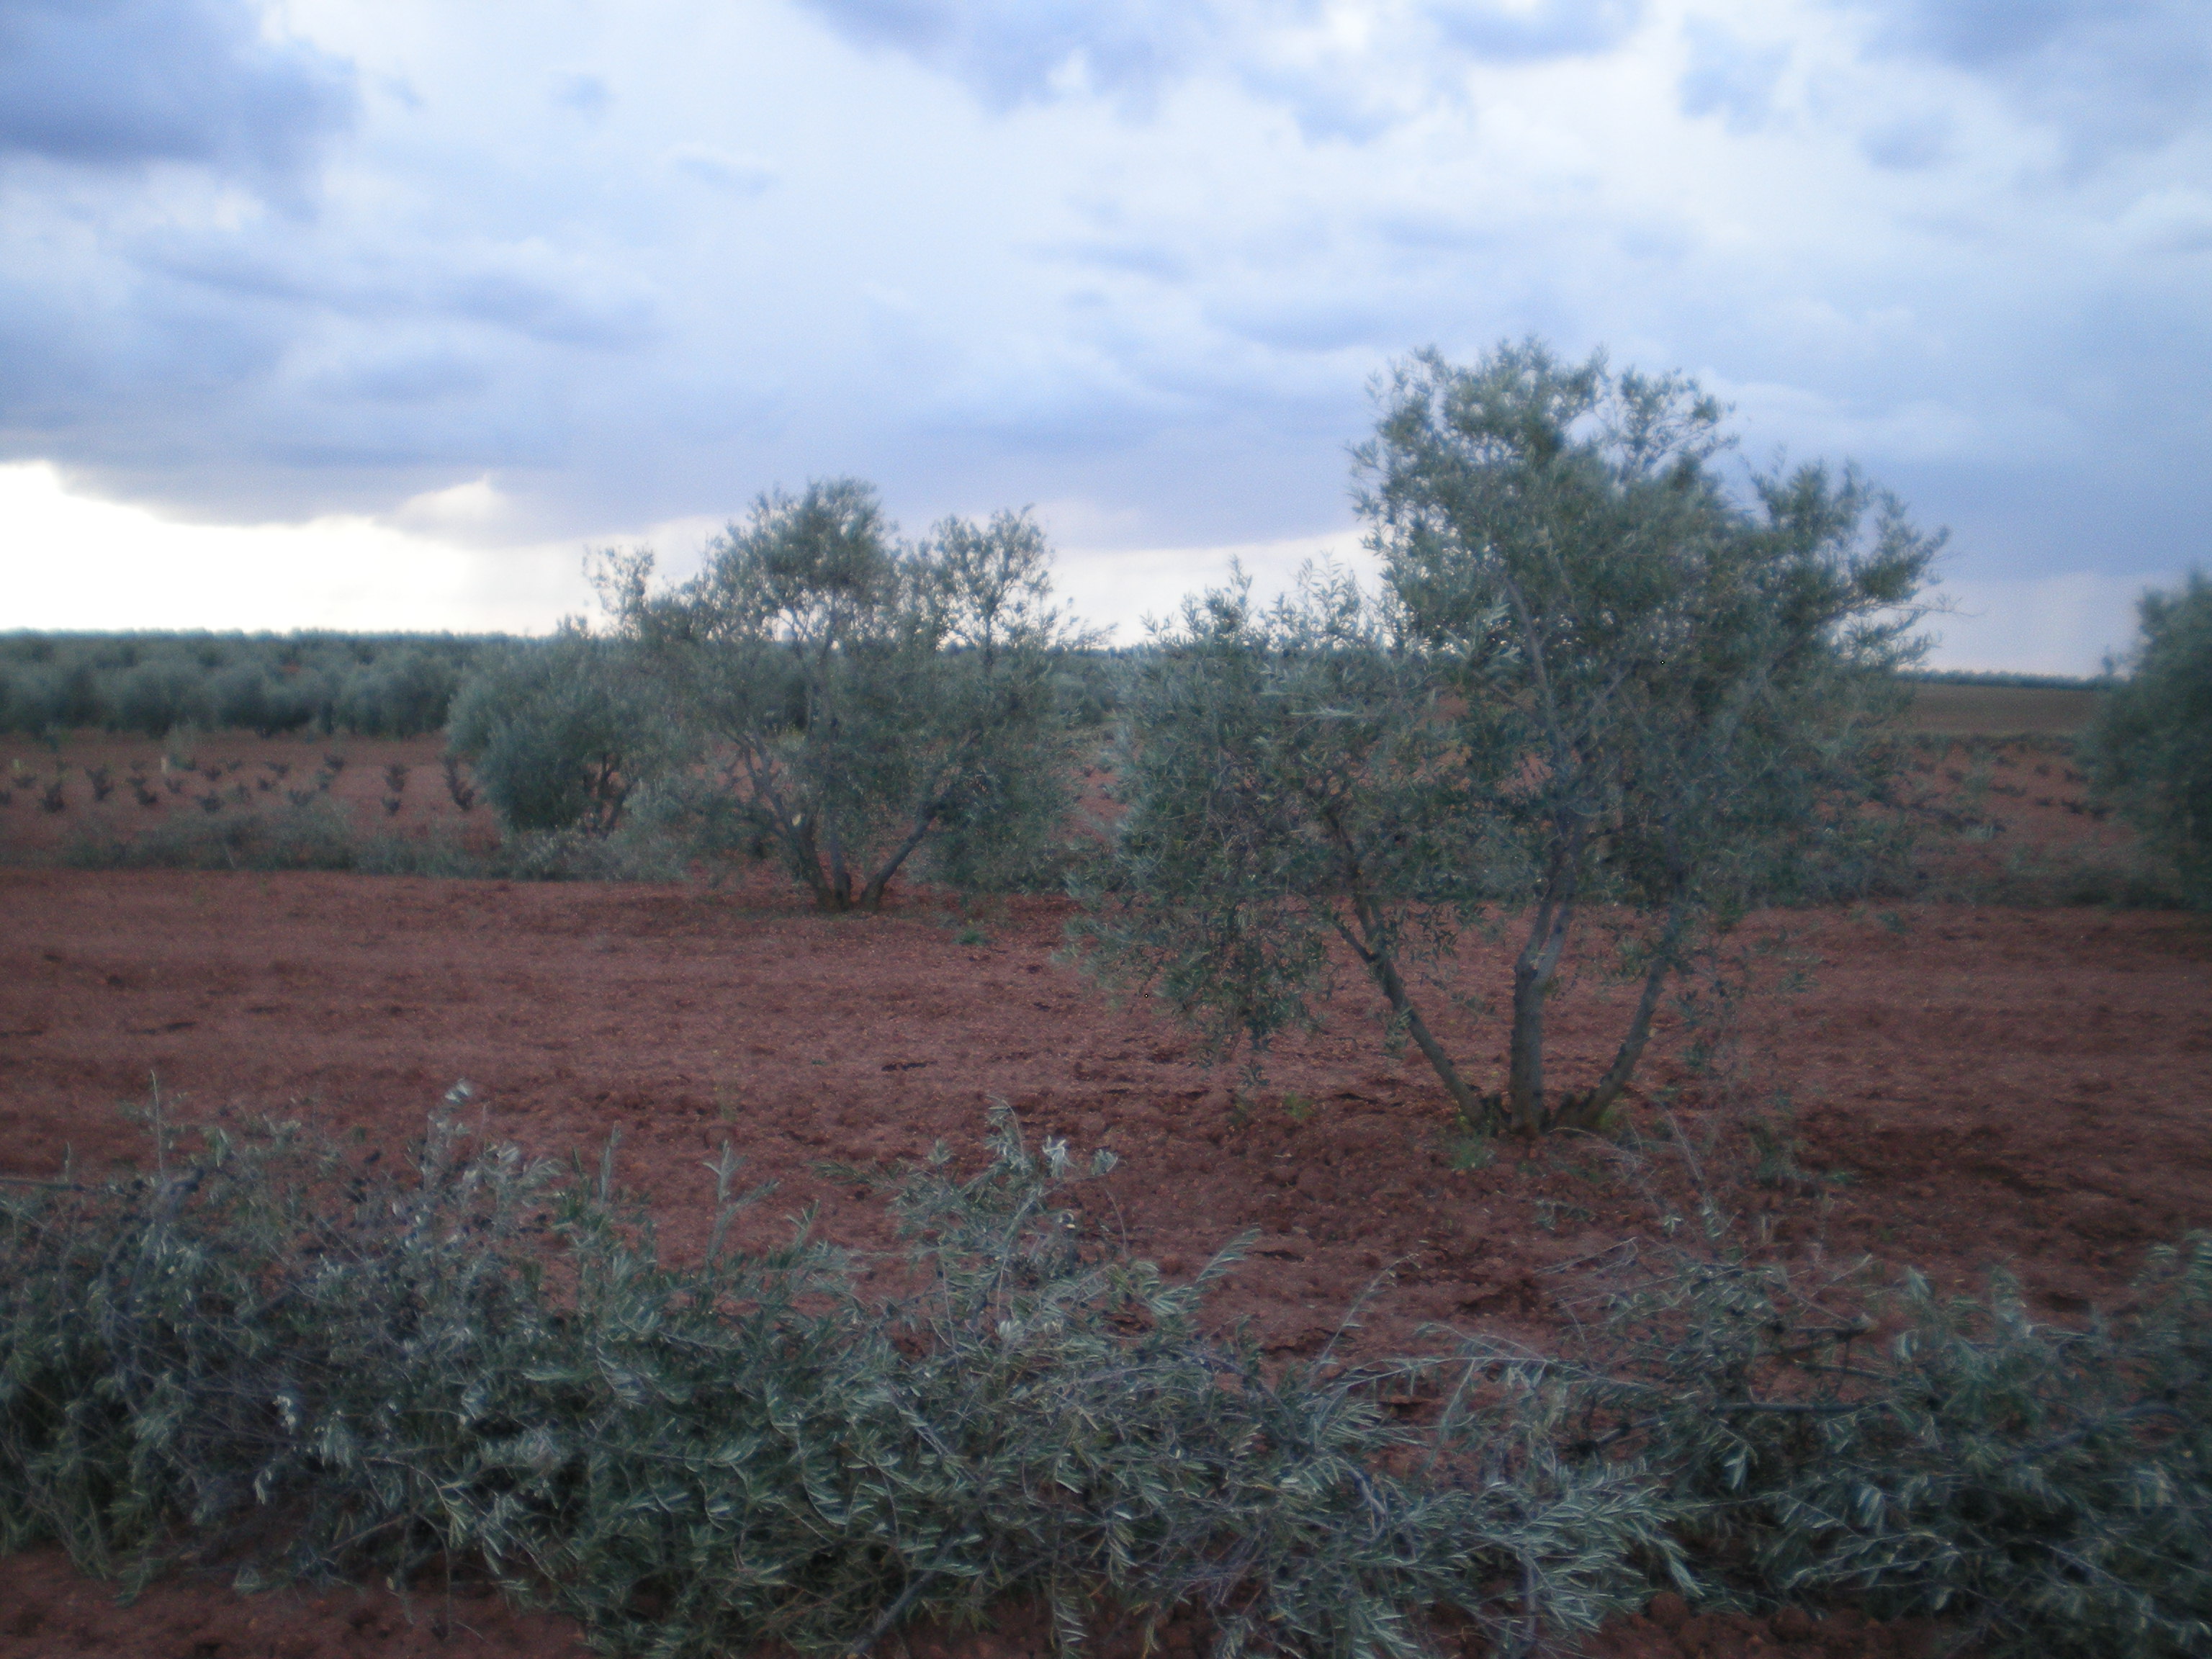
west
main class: Cropland
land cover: Olive groves
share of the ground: 10 - 25 %
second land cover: Other bare soil
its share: > 75 %
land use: Agriculture (excluding fallow land and kitchen gardens)
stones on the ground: < 10 %
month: April
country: ES
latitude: 38.6479
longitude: -3.3953
